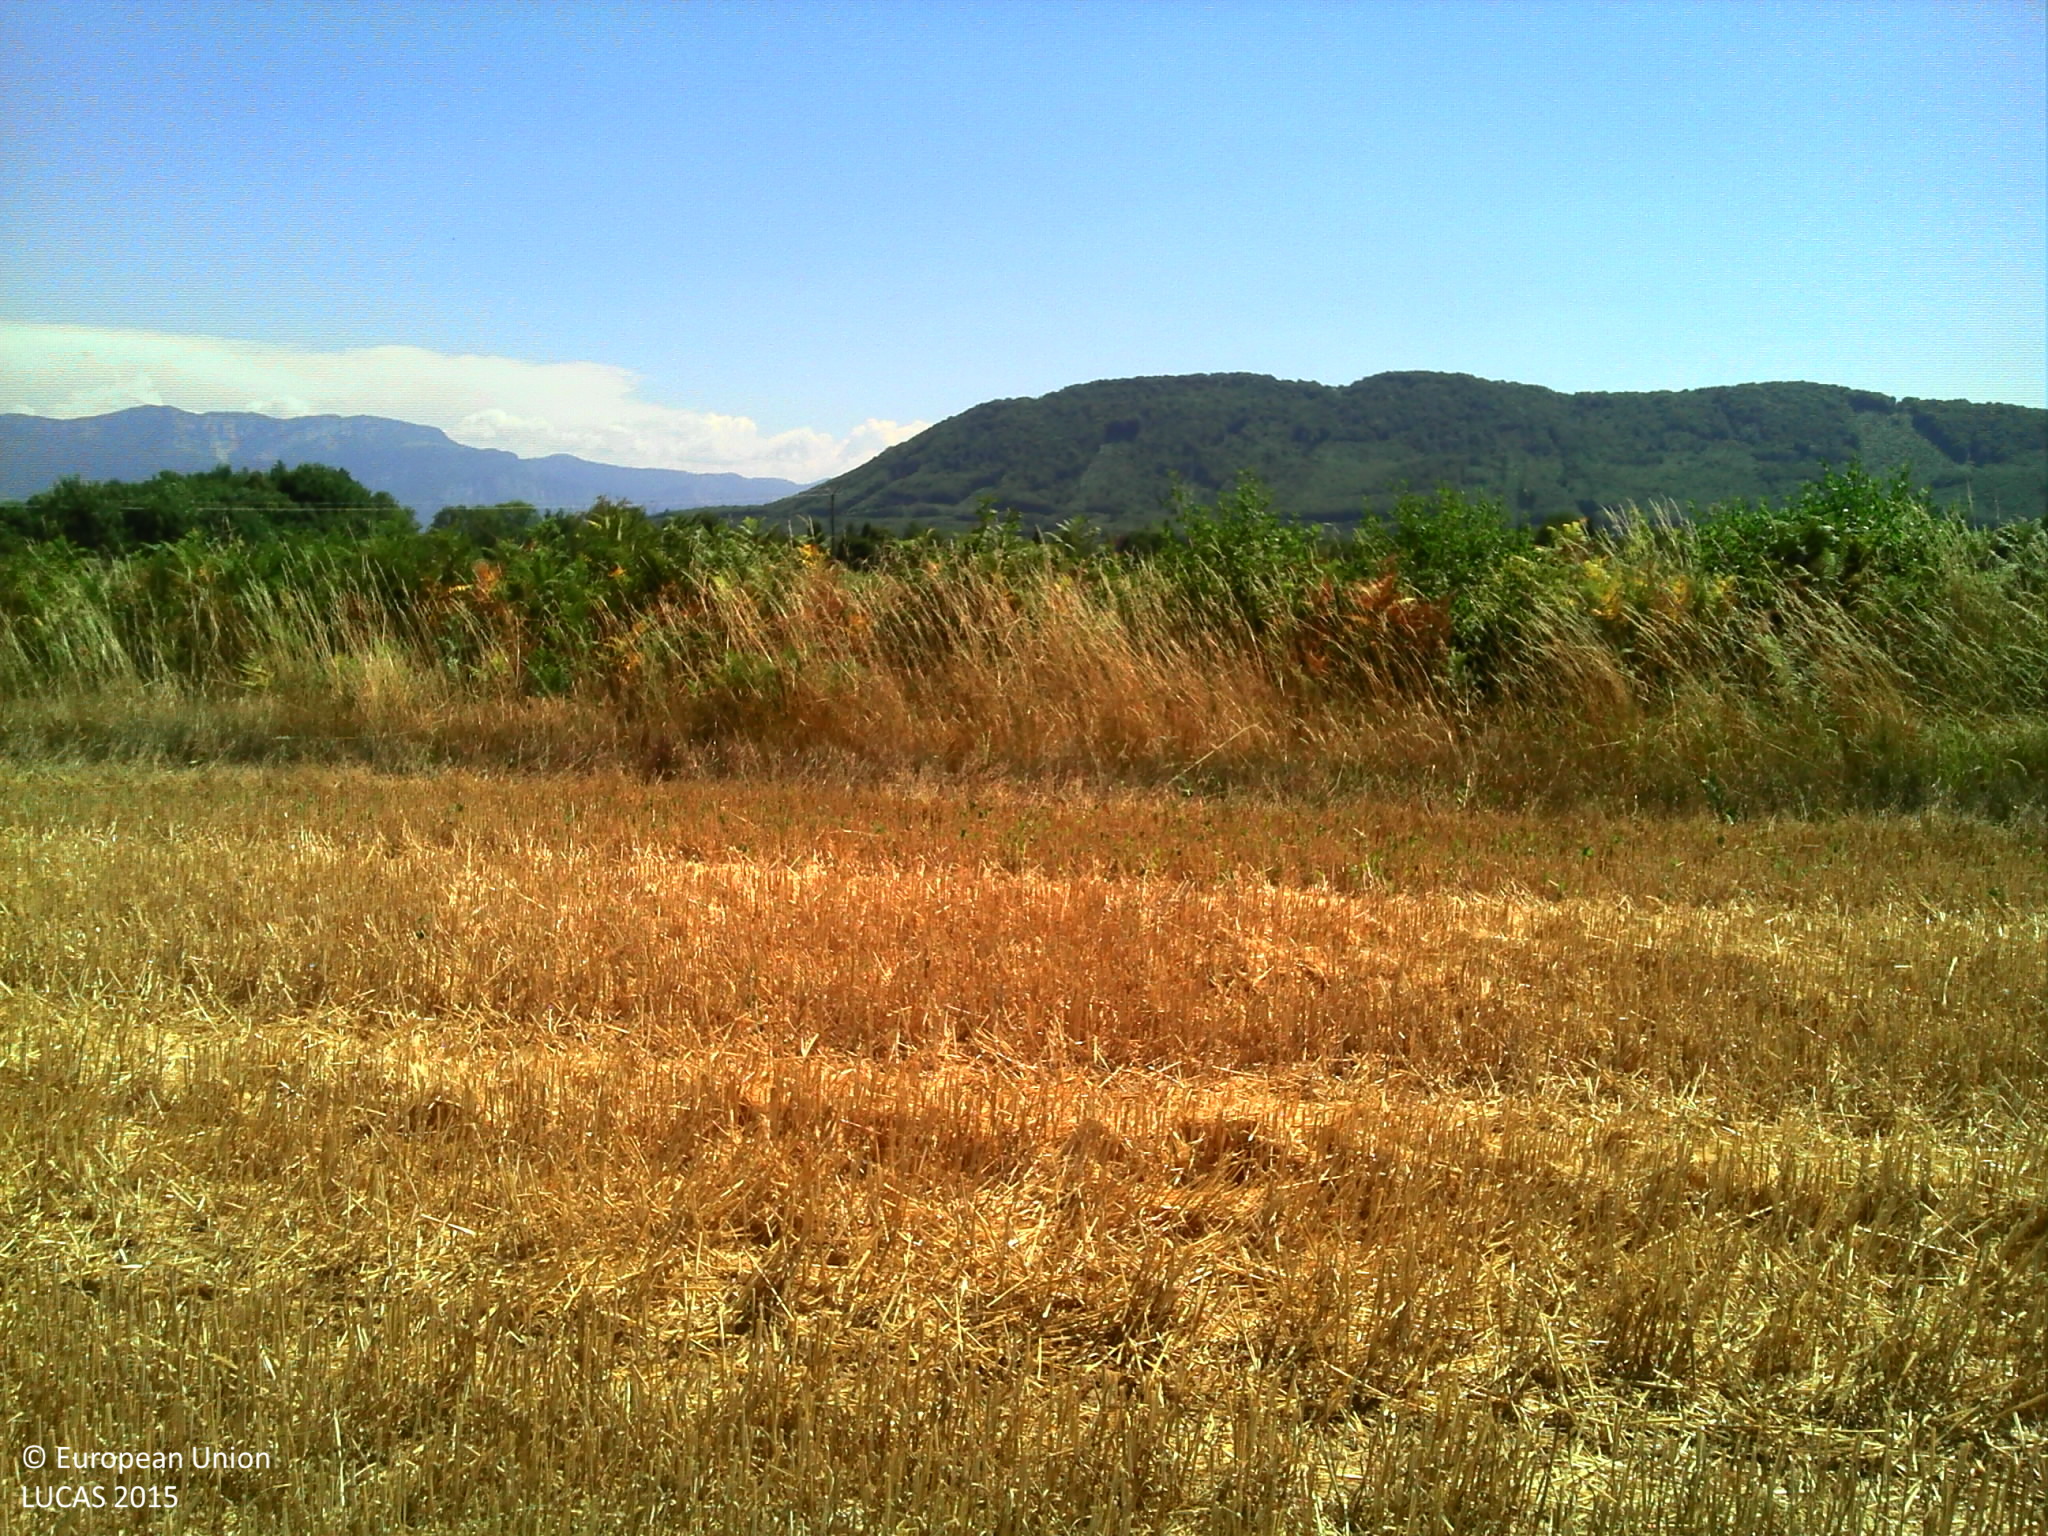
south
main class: Cropland
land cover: Durum wheat
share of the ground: > 75 %
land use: Agriculture (excluding fallow land and kitchen gardens)
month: July
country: FR
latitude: 45.3532
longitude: 5.4736
